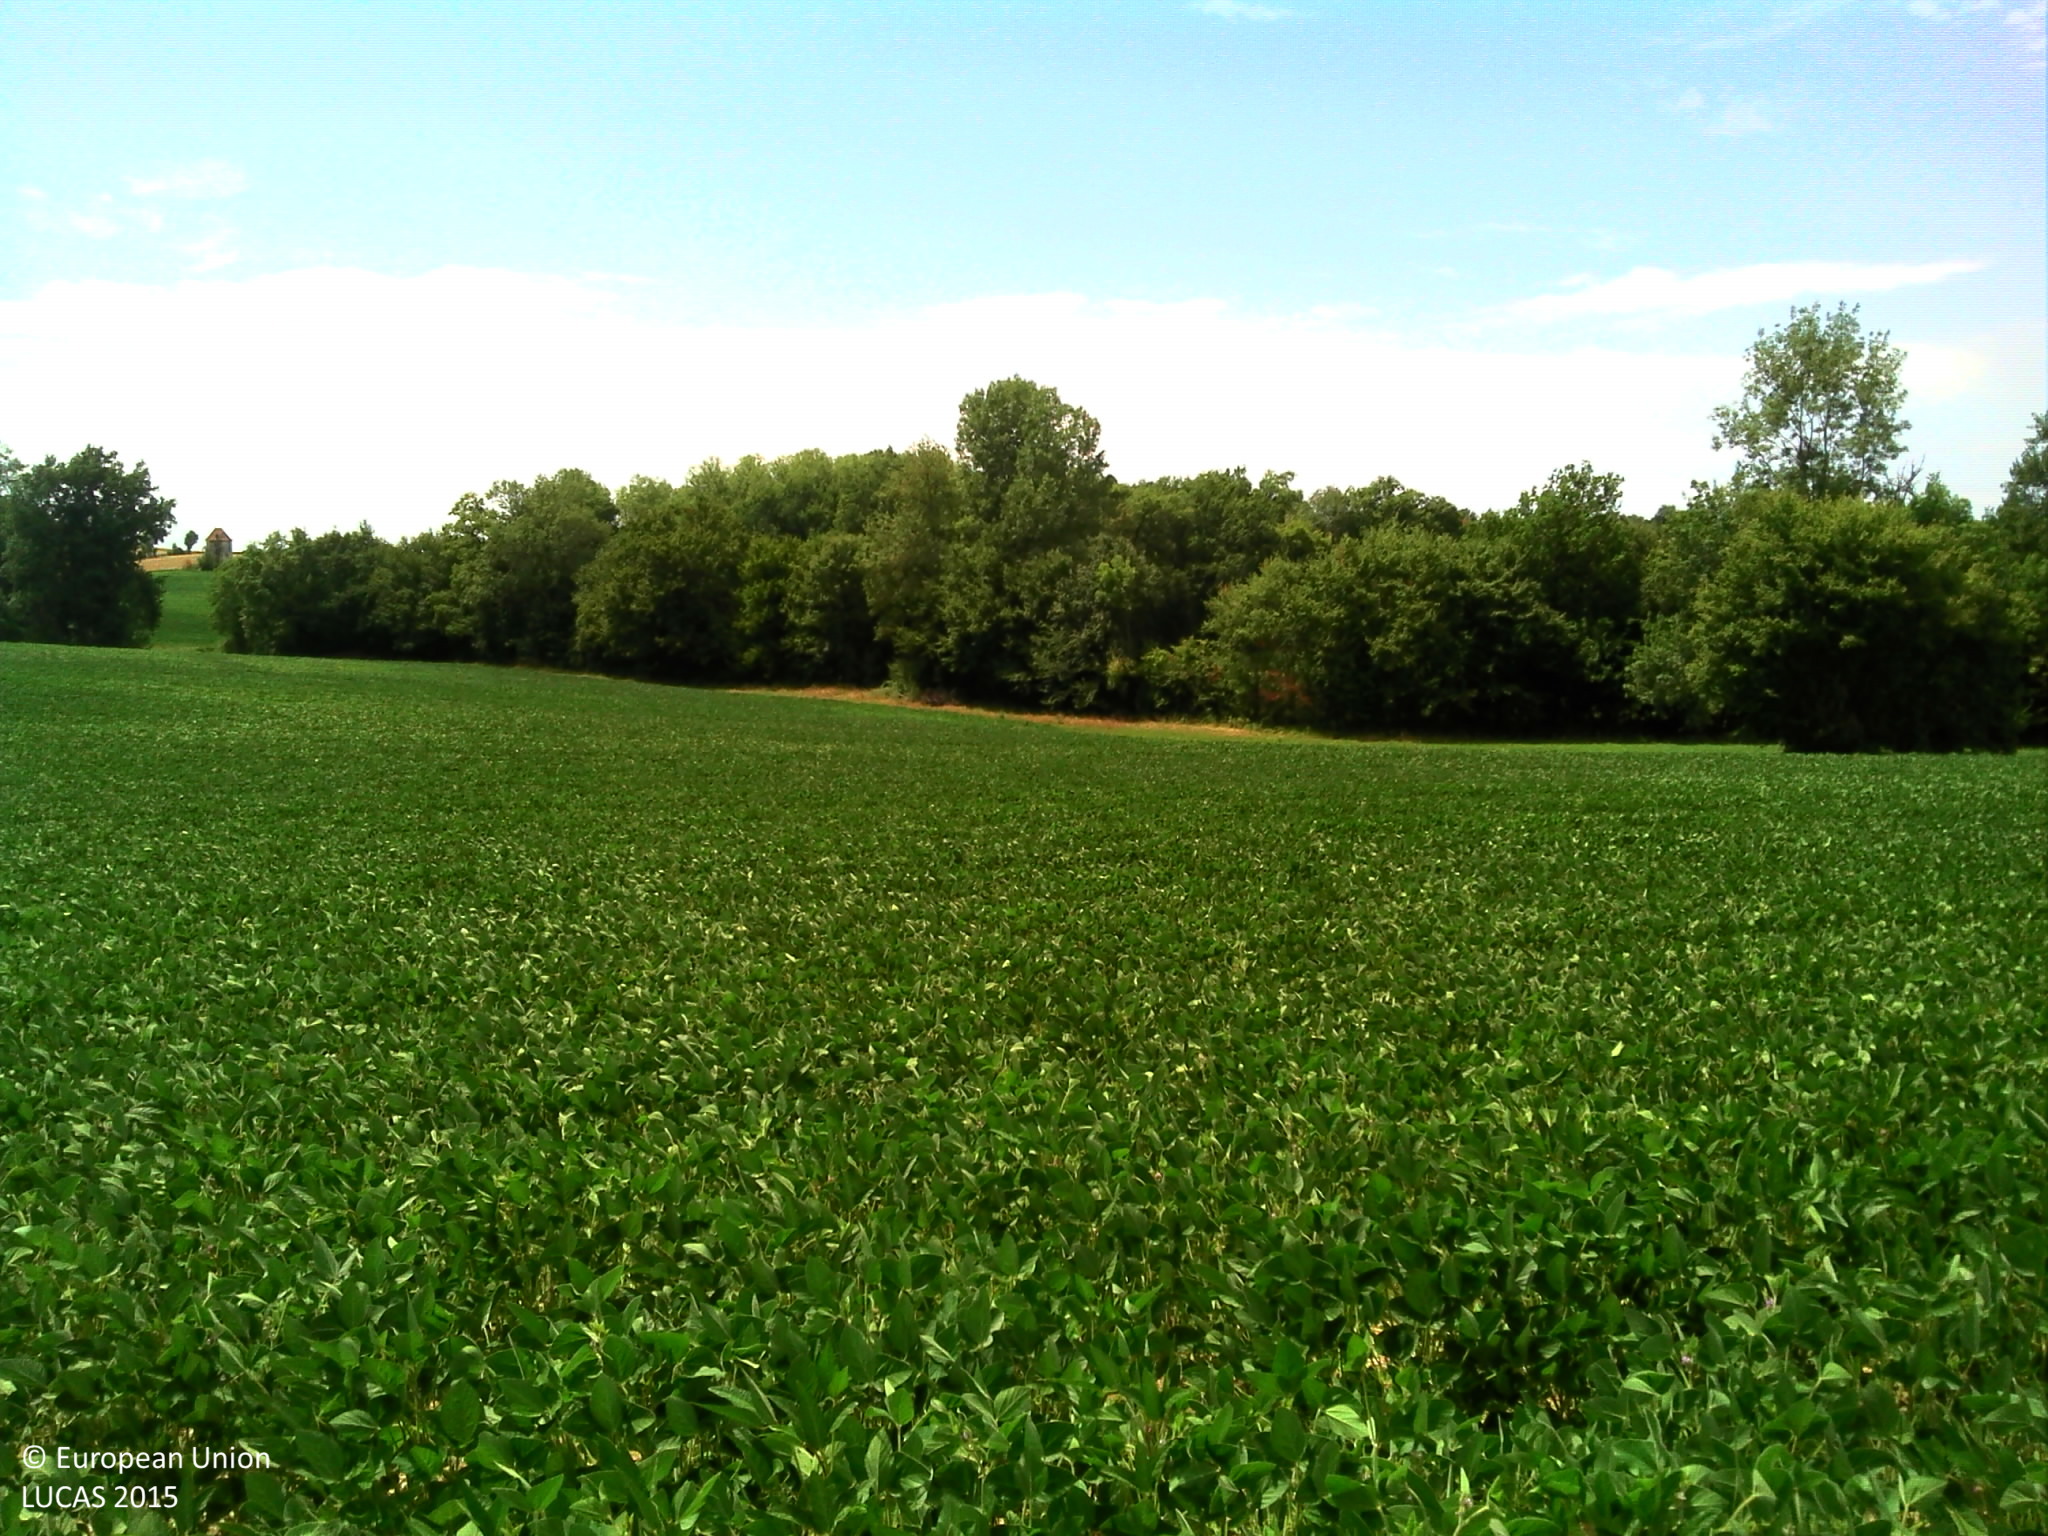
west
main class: Cropland
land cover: Soya
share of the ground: > 75 %
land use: Agriculture (excluding fallow land and kitchen gardens)
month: July
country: FR
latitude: 44.6442
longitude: 0.5483
